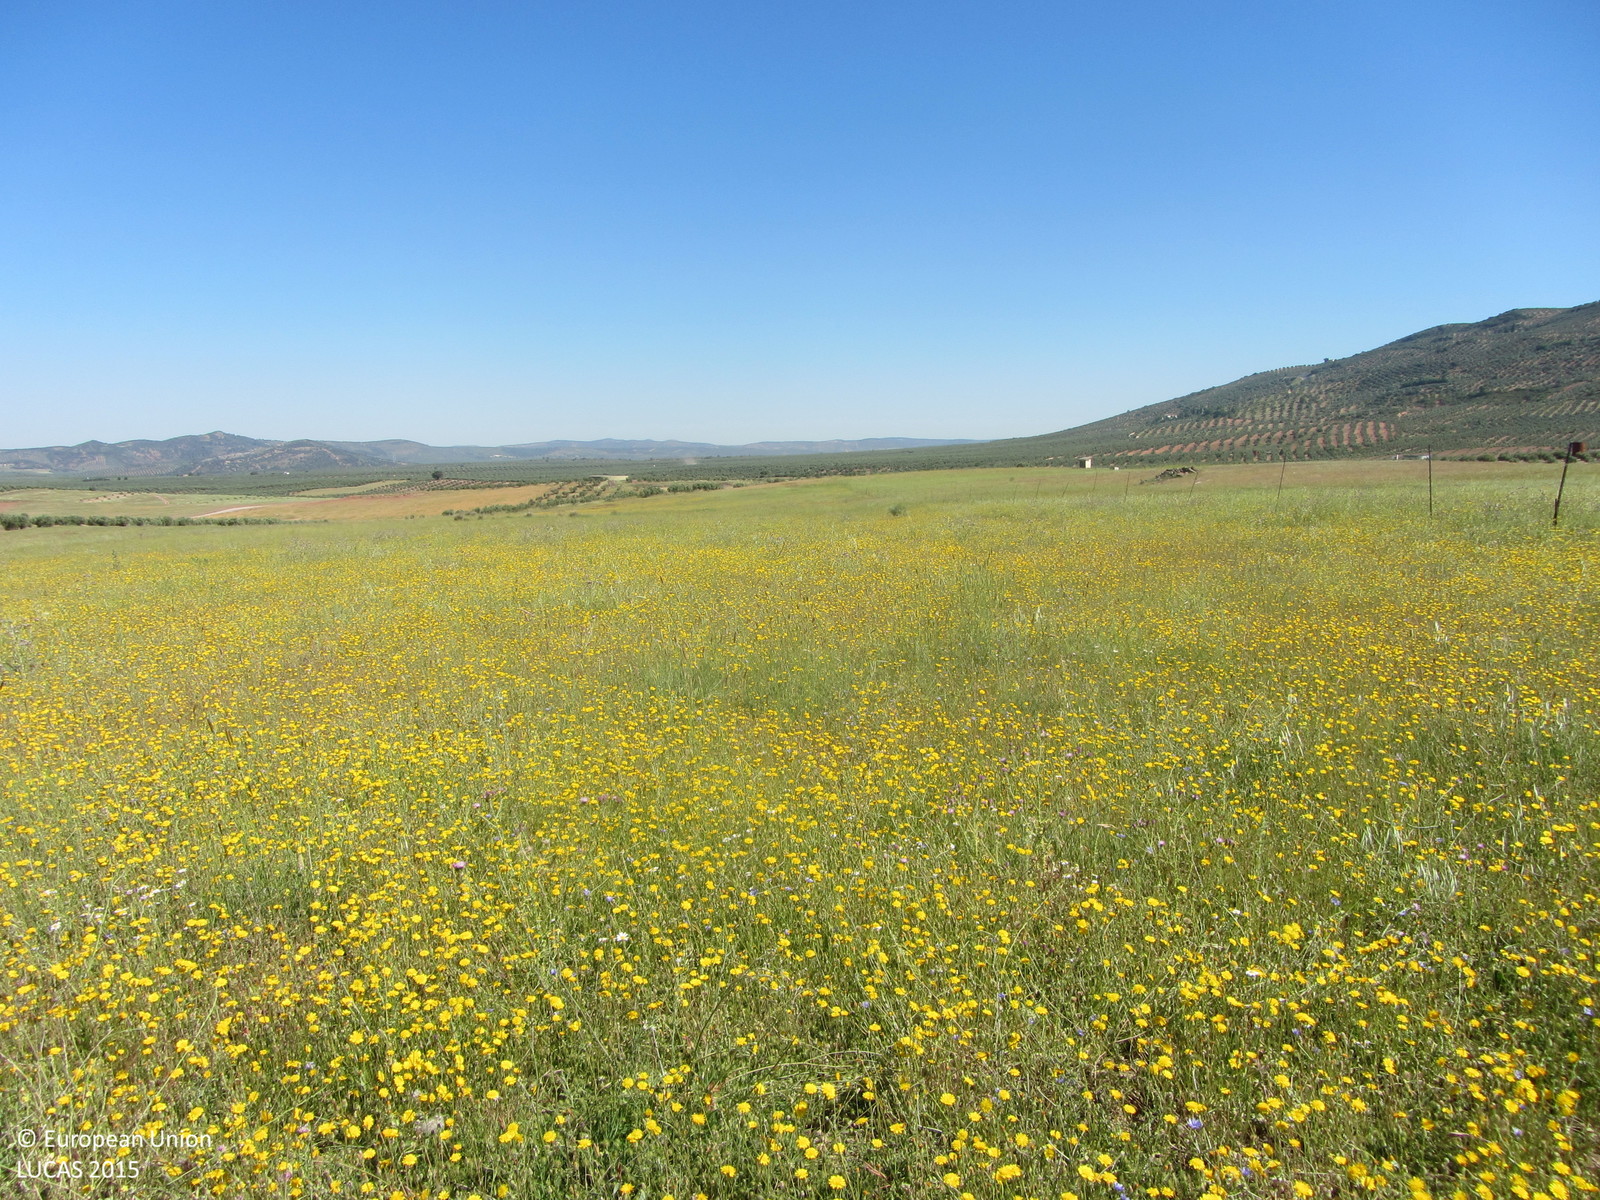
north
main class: Grassland
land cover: Spontaneously vegetated surfaces
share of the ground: > 75 %
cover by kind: herbaceous plants 100 %
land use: Fallow land
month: May
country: ES
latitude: 38.2660
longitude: -3.1108
